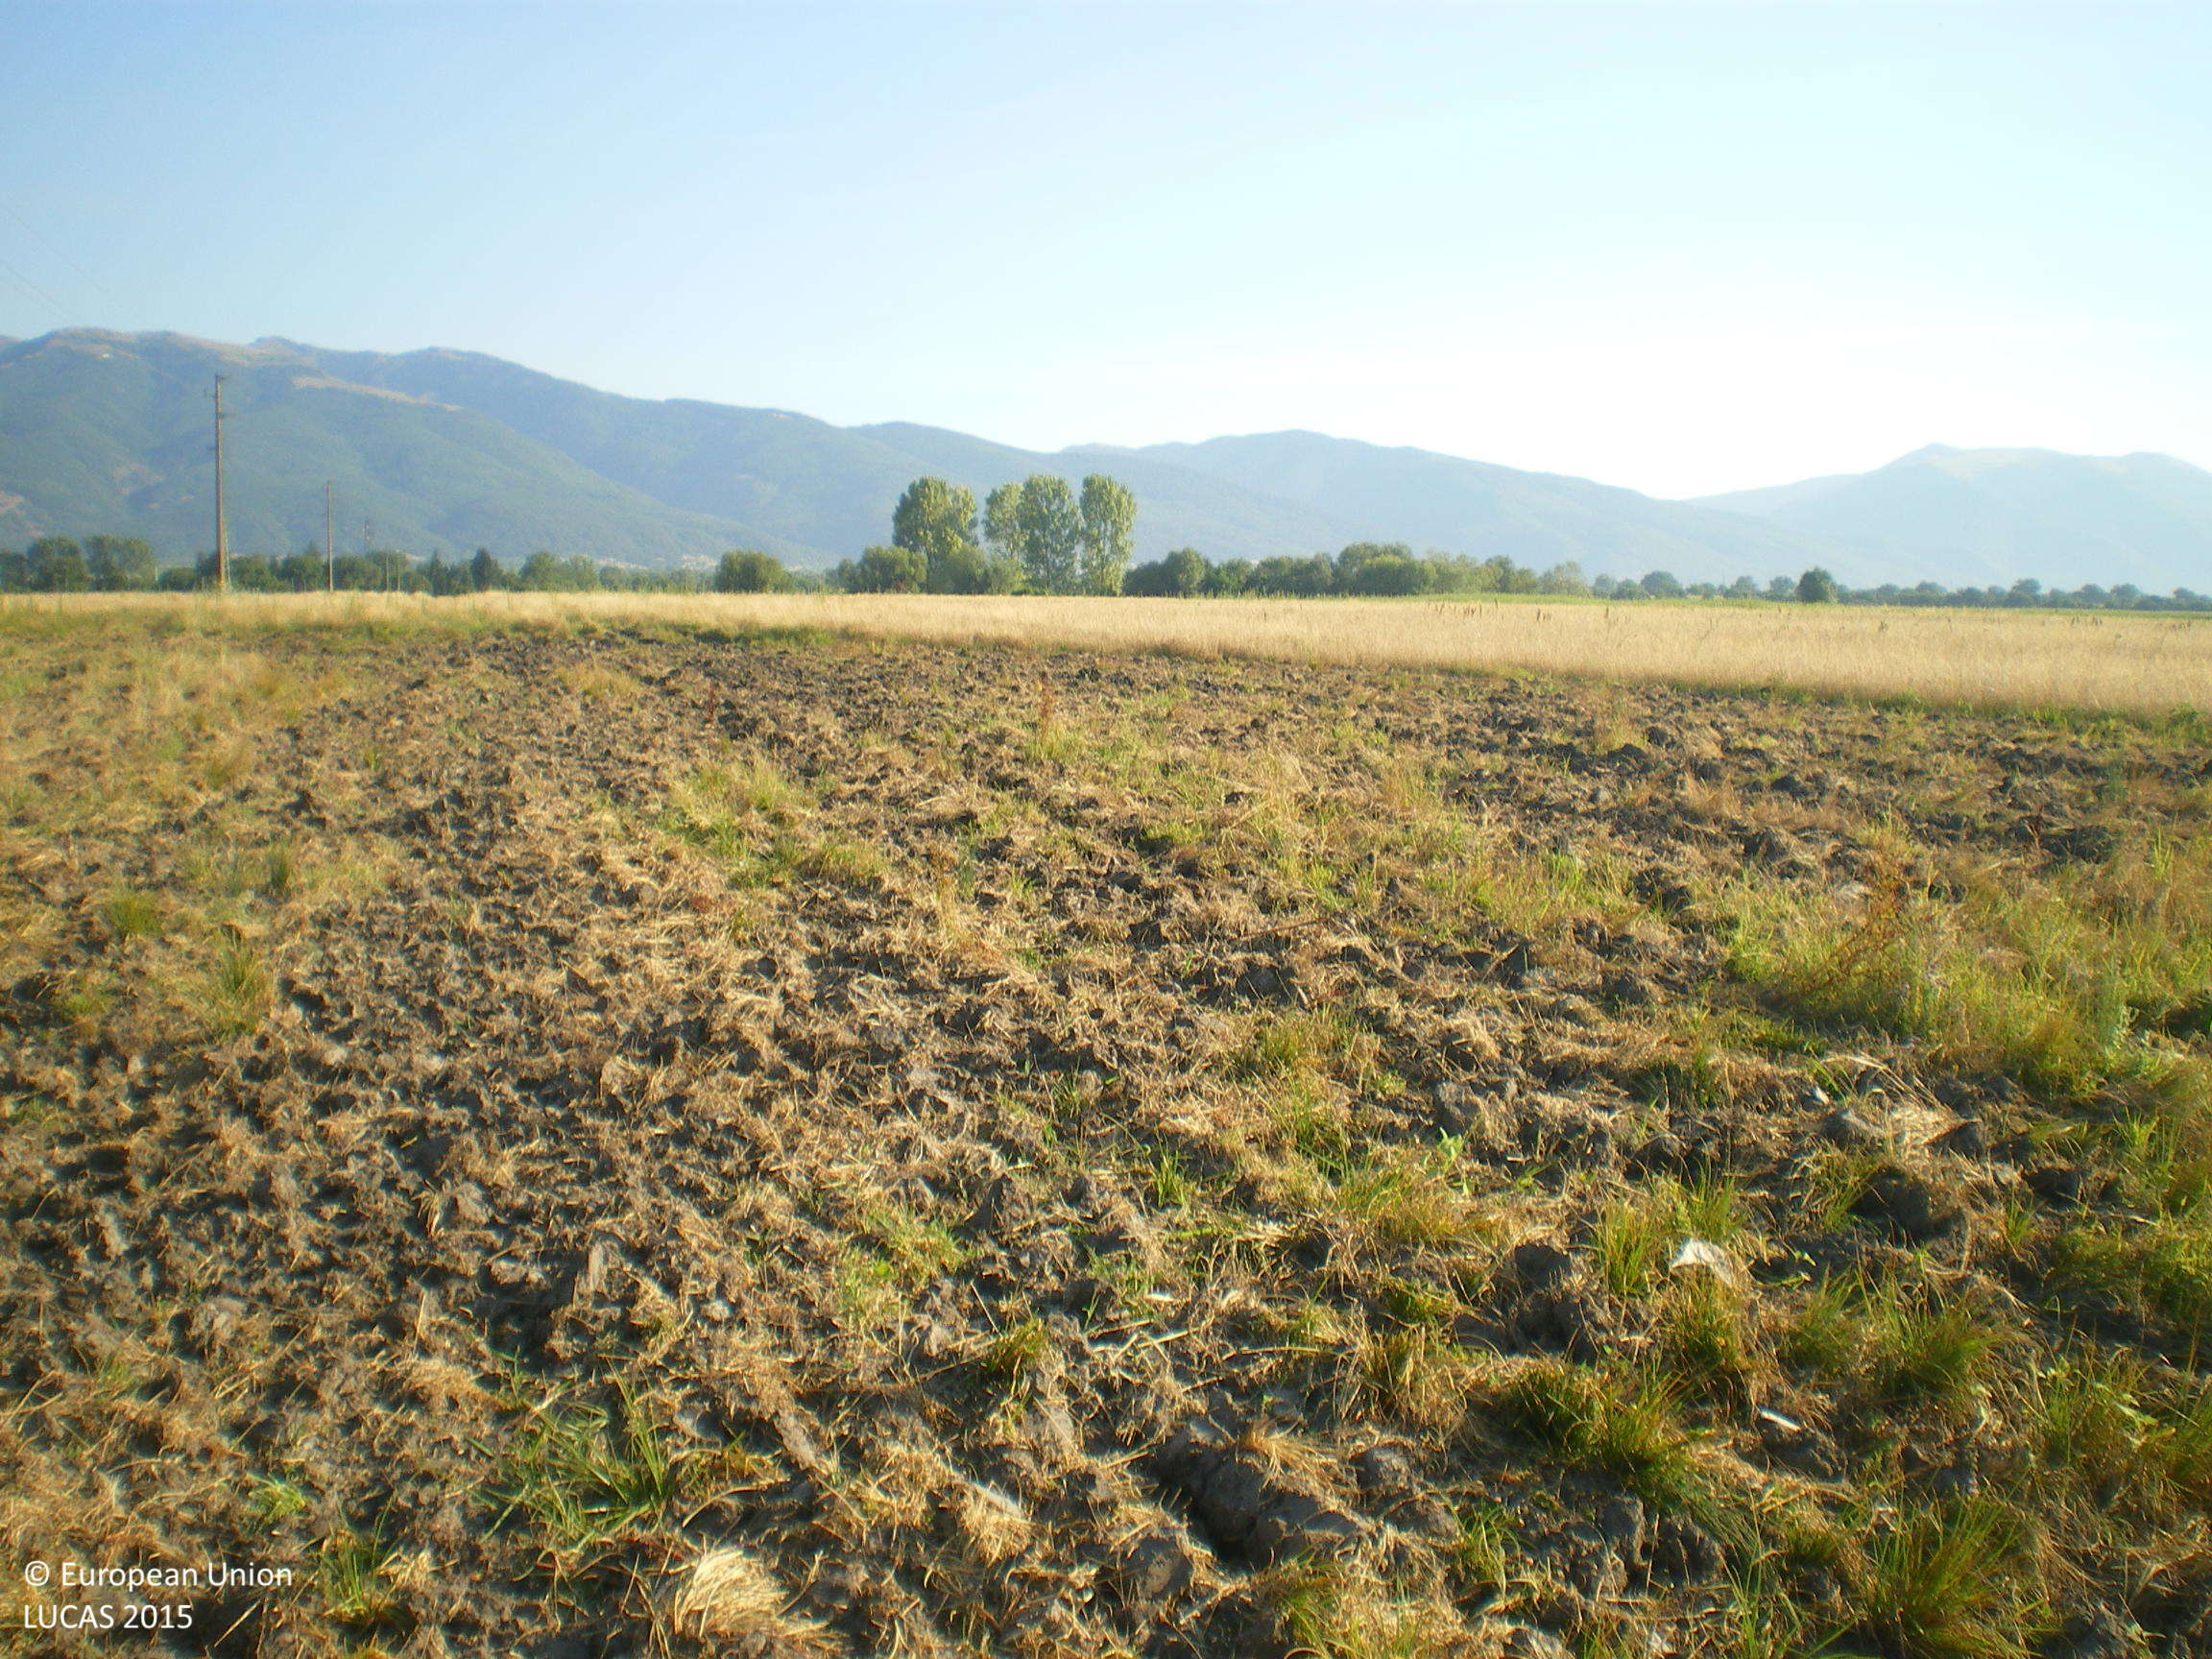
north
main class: Grassland
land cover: Spontaneously vegetated surfaces
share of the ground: 50 - 75 %
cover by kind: herbaceous plants 50 %, unconsolidated bare surface 50 %
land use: Agriculture (excluding fallow land and kitchen gardens)
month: July
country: BG
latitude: 42.6223
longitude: 25.1712
